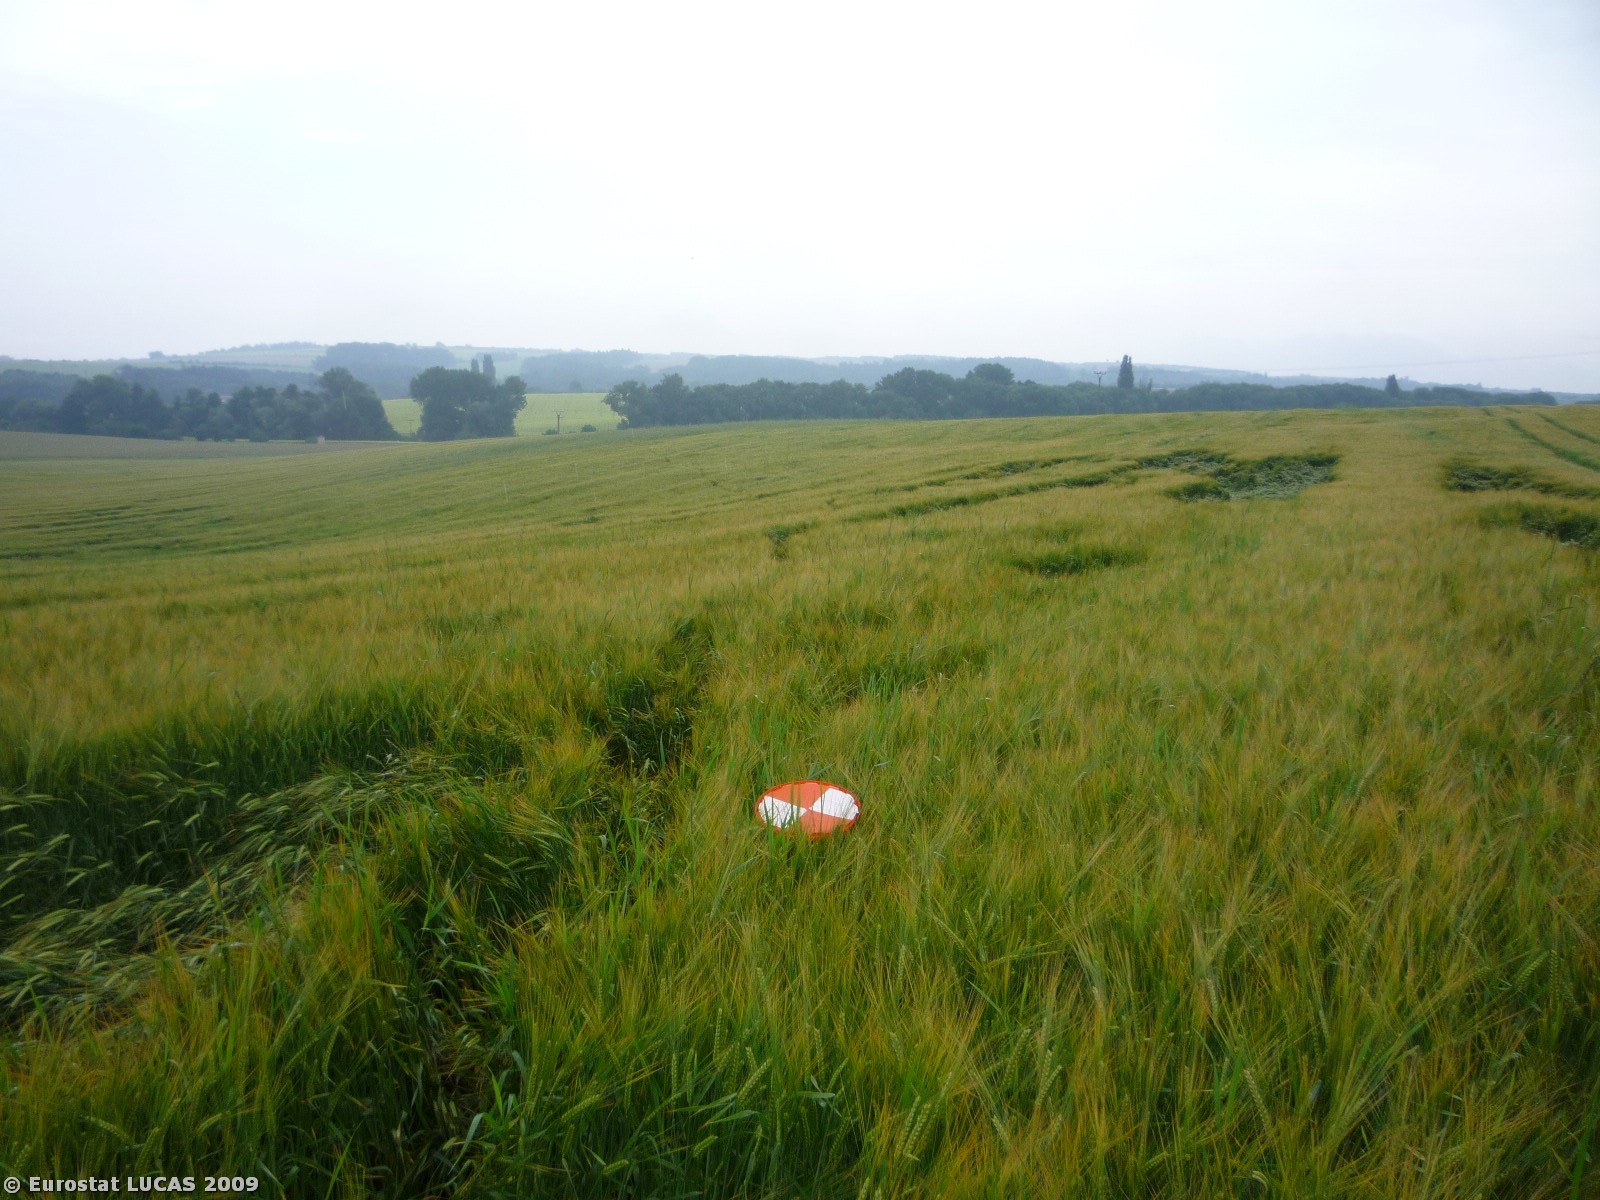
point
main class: Cropland
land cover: Barley
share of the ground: > 75 %
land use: Agriculture (excluding fallow land and kitchen gardens)
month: July
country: CZ
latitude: 50.0248
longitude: 14.9019
